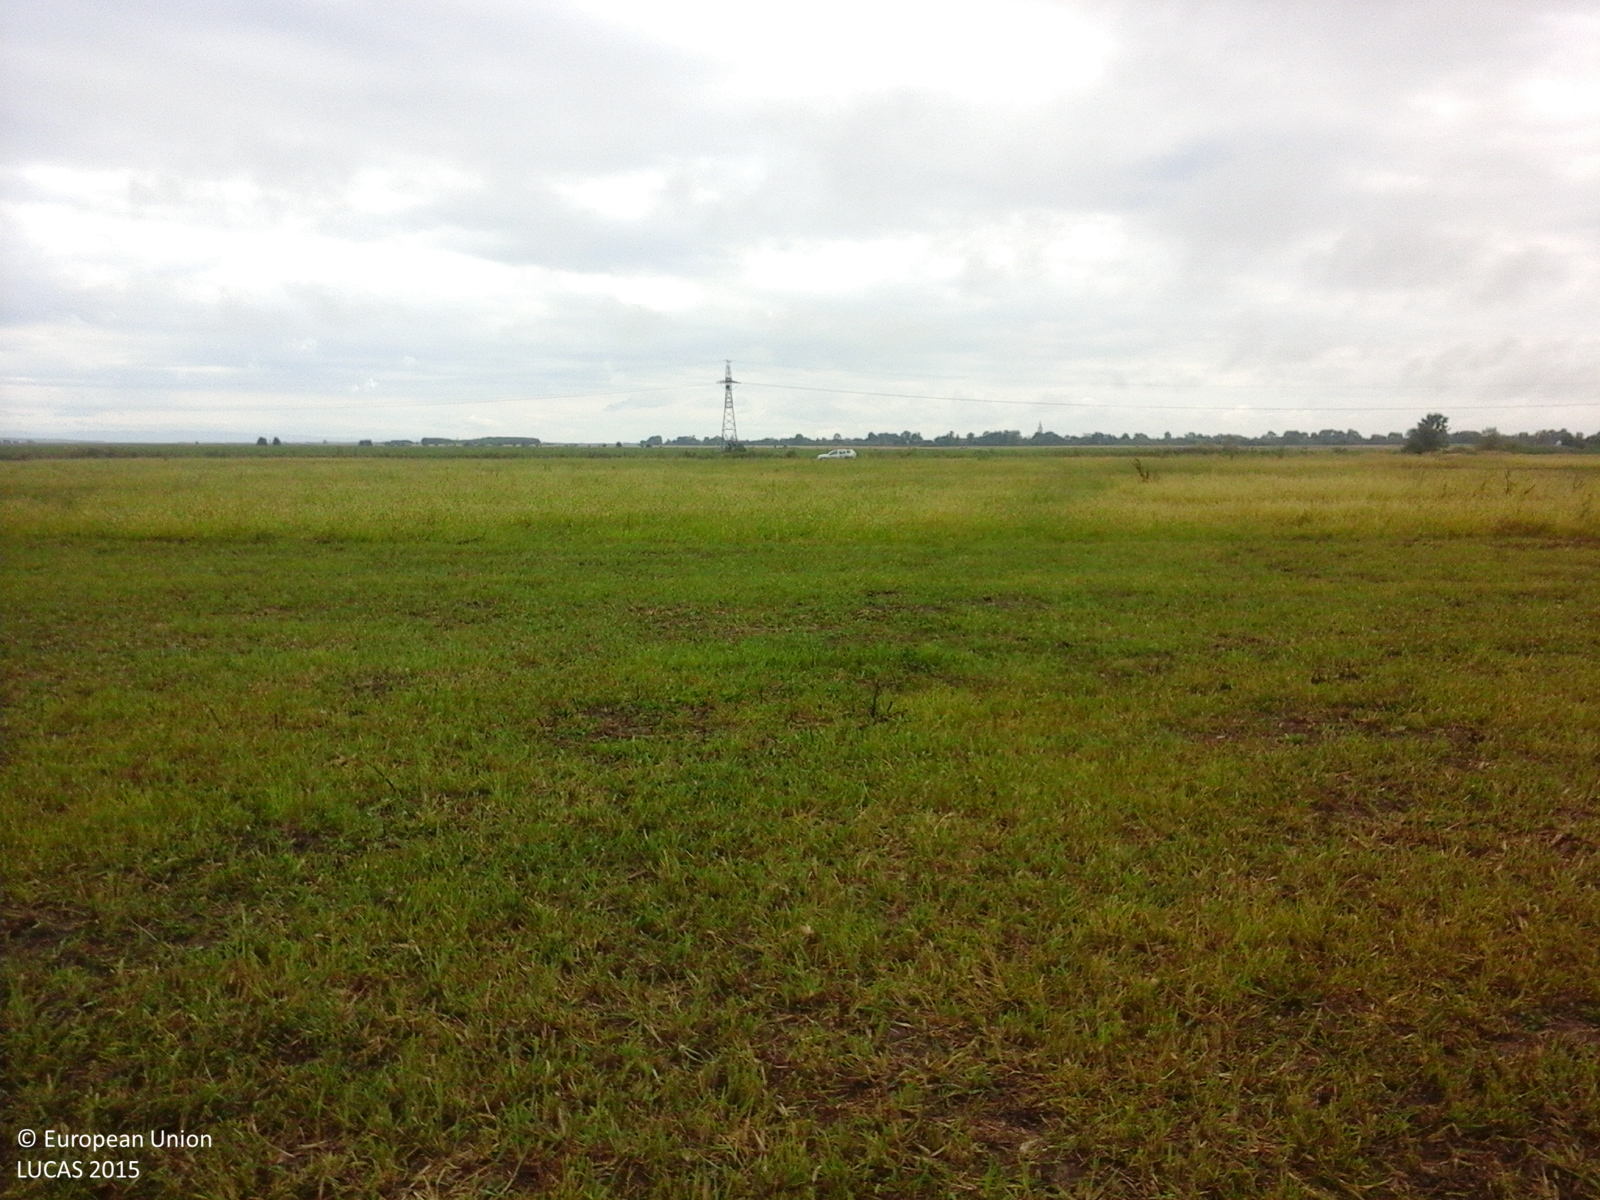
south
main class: Grassland
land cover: Grassland without tree/shrub cover
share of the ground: > 75 %
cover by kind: herbaceous plants 100 %
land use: Agriculture (excluding fallow land and kitchen gardens)
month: August
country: RO
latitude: 45.6362
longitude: 21.5148
